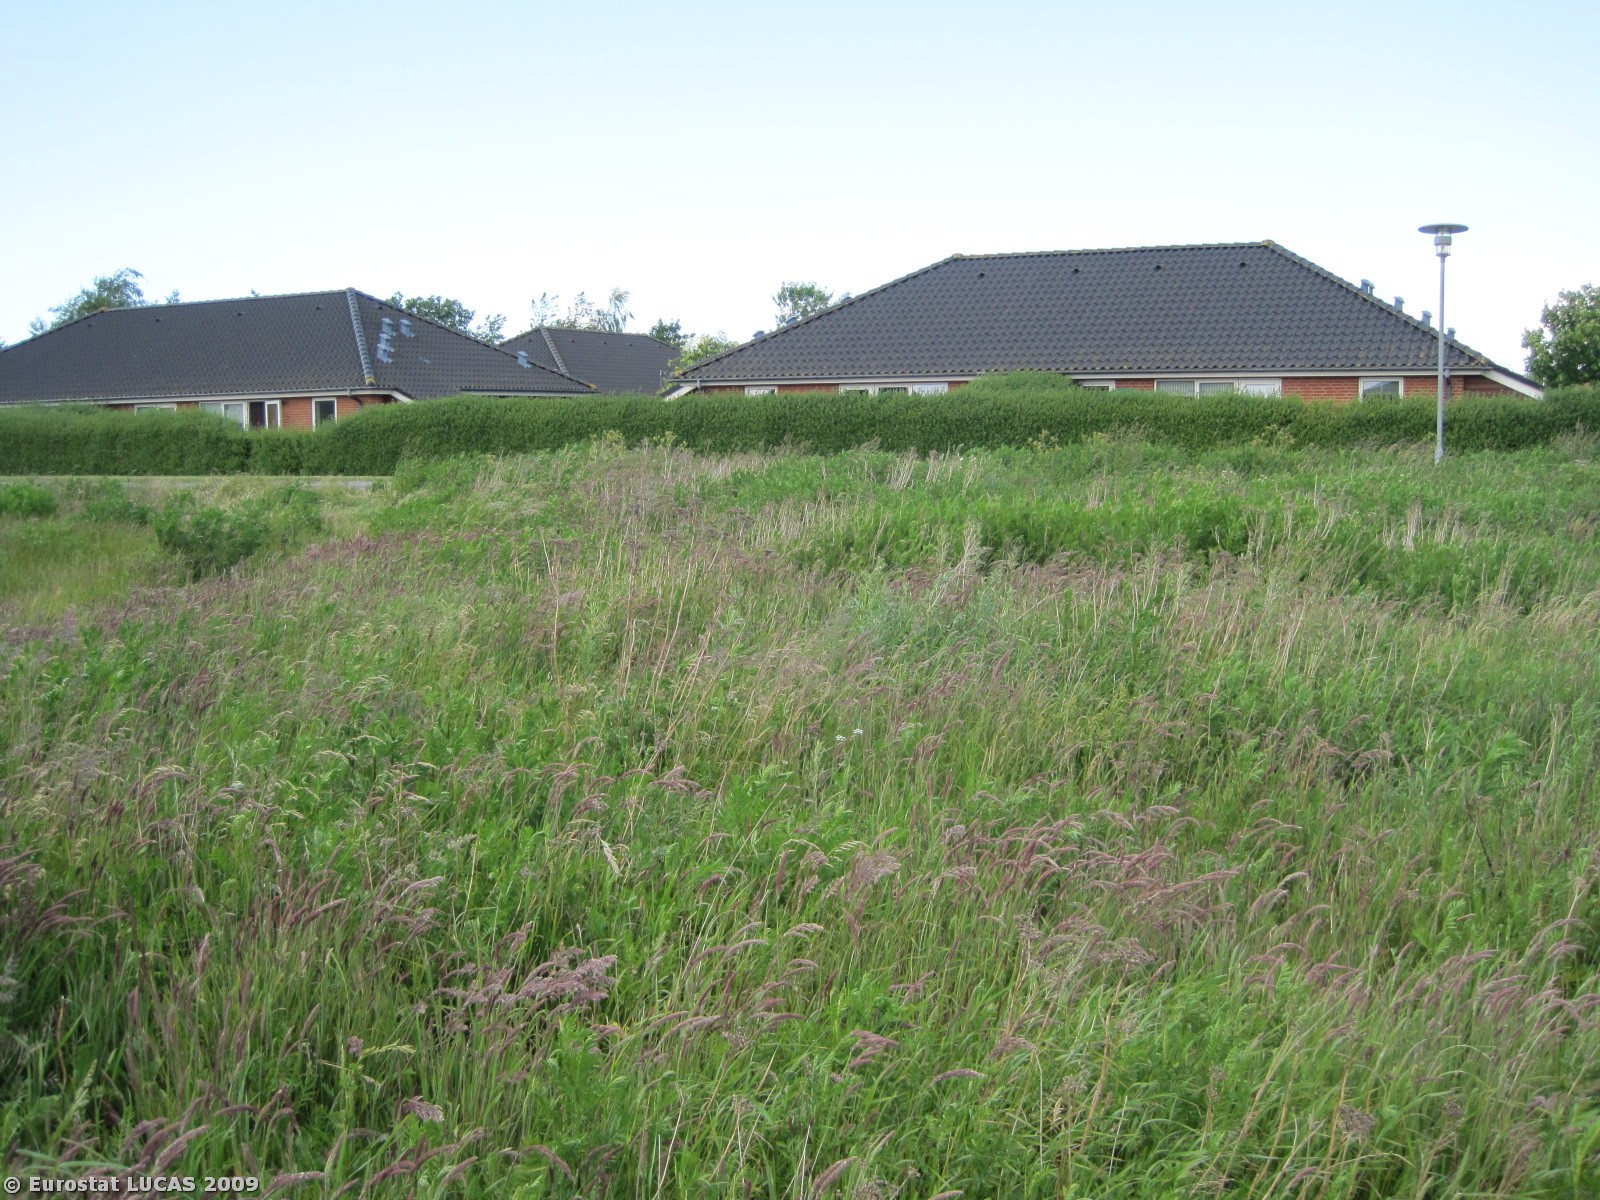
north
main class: Grassland
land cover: Grassland without tree/shrub cover
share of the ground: > 75 %
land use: Unused
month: June
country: DK
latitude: 57.1583
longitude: 9.7524
